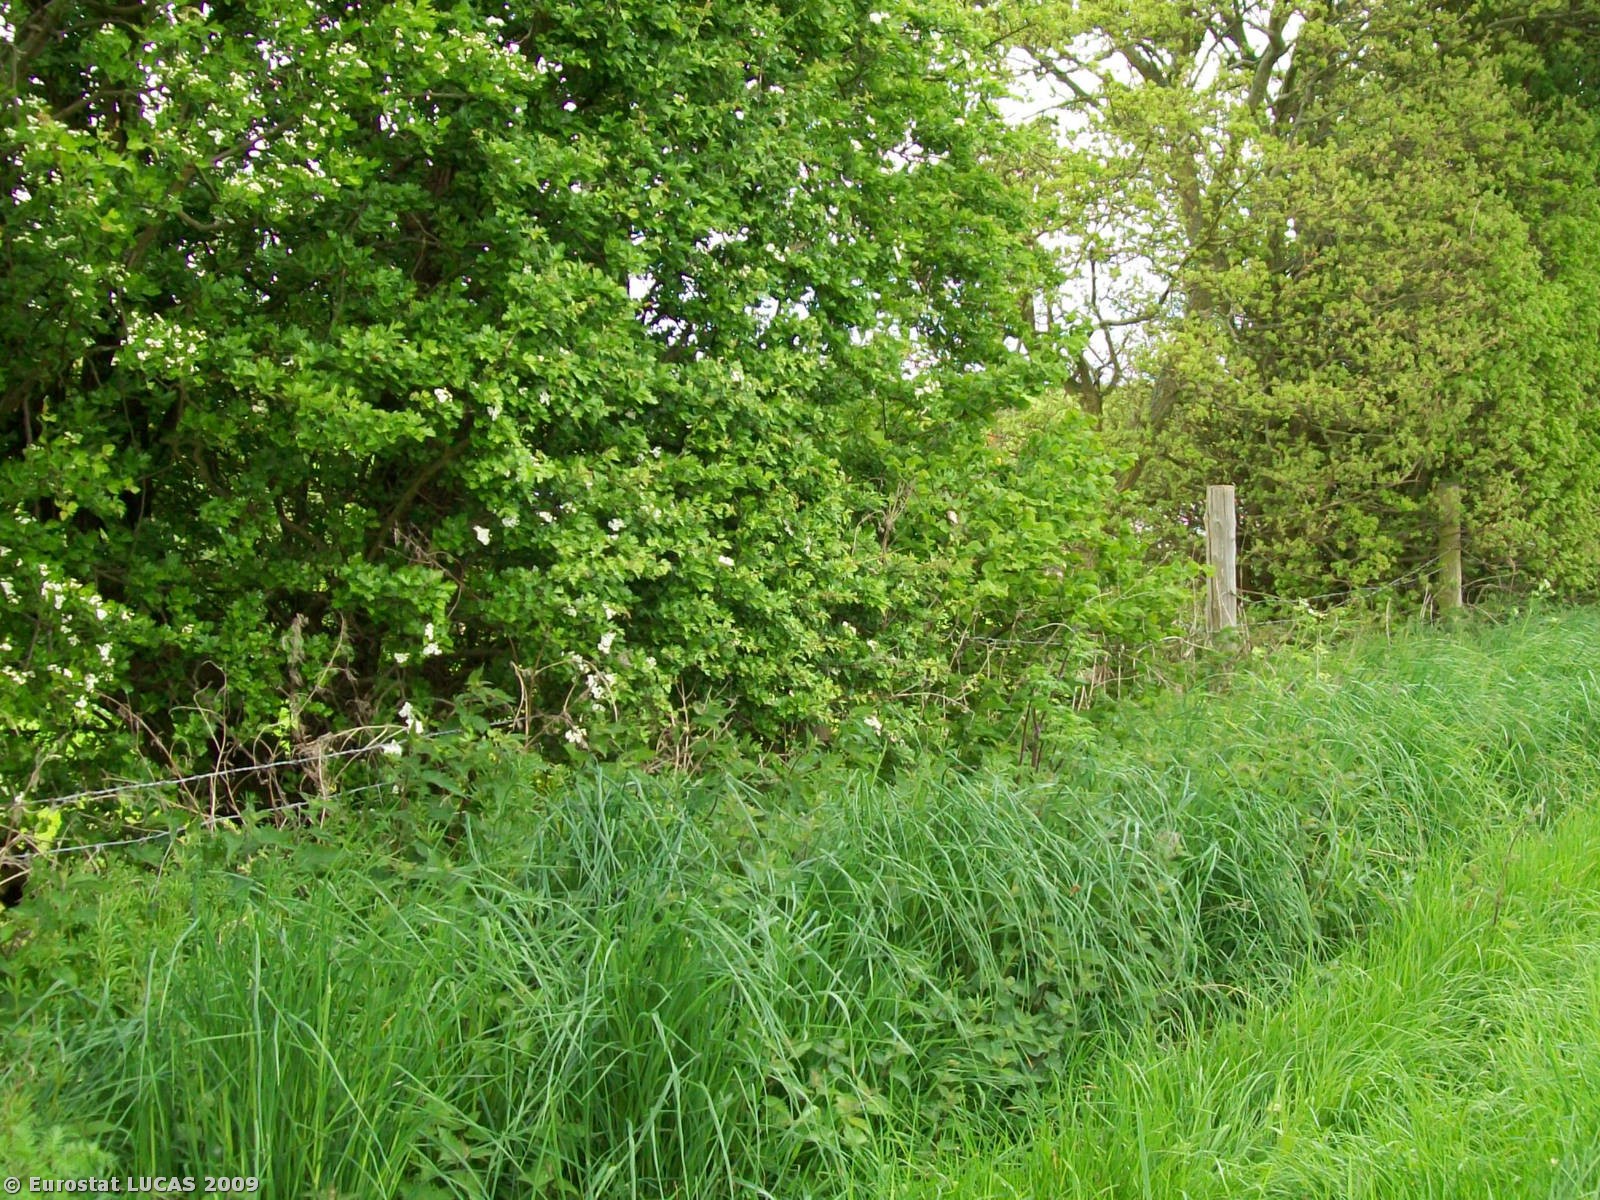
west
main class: Cropland
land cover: Oats
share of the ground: > 75 %
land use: Agriculture (excluding fallow land and kitchen gardens)
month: May
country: GB
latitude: 52.3036
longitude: -2.4281
